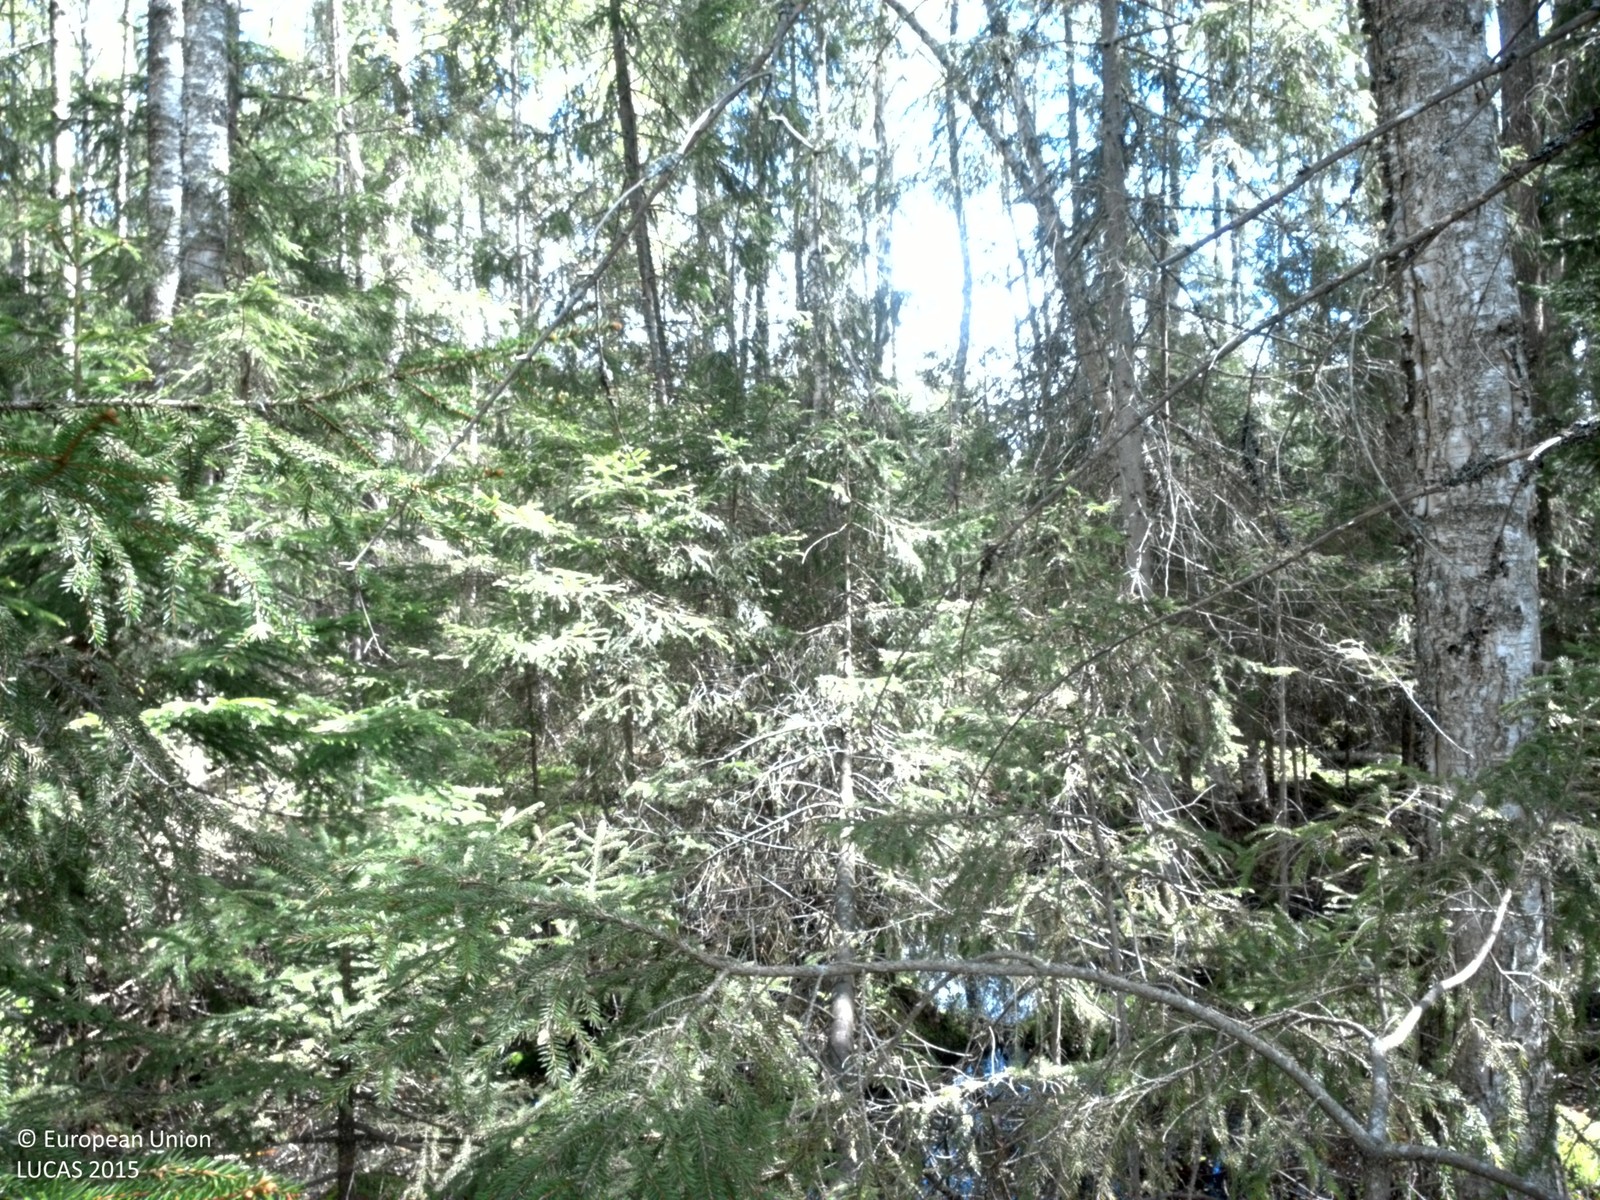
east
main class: Woodland
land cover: Spruce dominated mixed woodland
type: boreal forest
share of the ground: > 75 %
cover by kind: broadleaved forest trees 50 %, coniferous forest trees 40 %, lichens and mosses 10 %
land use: Forestry
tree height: > 5 m
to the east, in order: Spruce dominated mixed woodland; Shrubland with sparse tree cover; Spruce dominated coniferous woodland; Spruce dominated mixed woodland; Broadleaved woodland
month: May
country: SE
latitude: 56.7319
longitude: 15.1794
